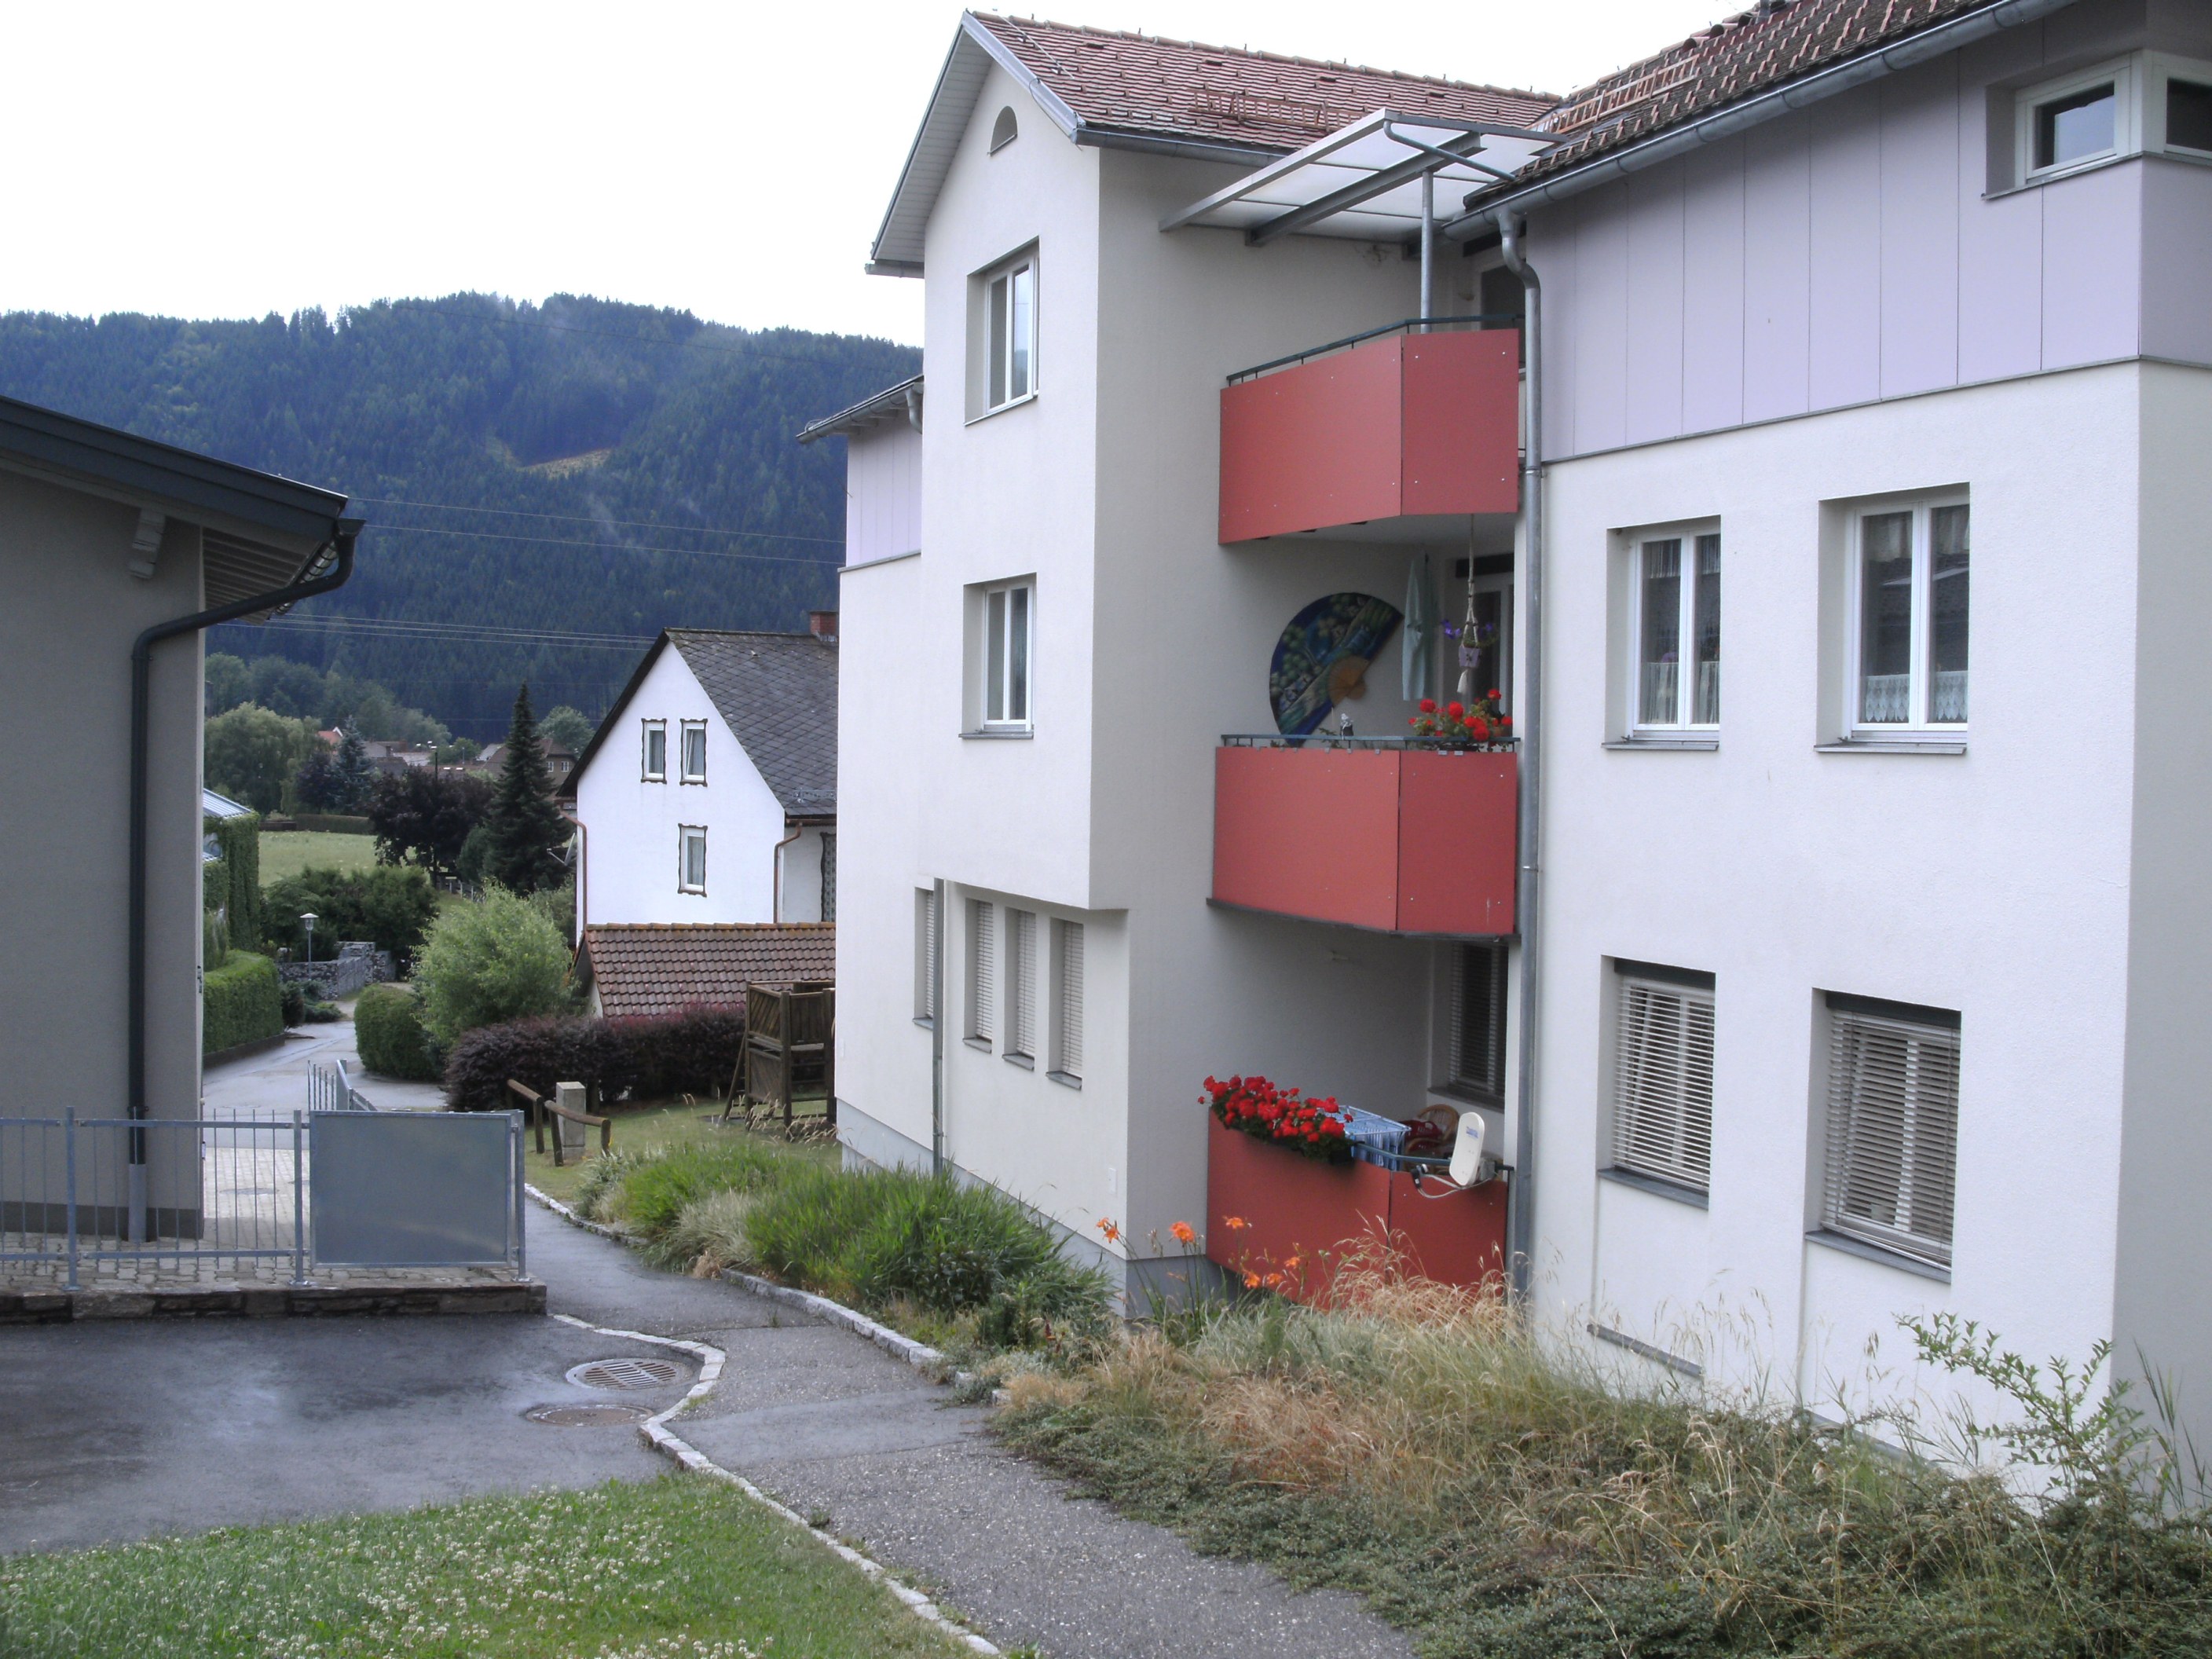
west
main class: Grassland
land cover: Grassland without tree/shrub cover
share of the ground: > 75 %
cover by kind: herbaceous plants 100 %
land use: Residential
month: July
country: AT
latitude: 46.9652
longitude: 14.7956
